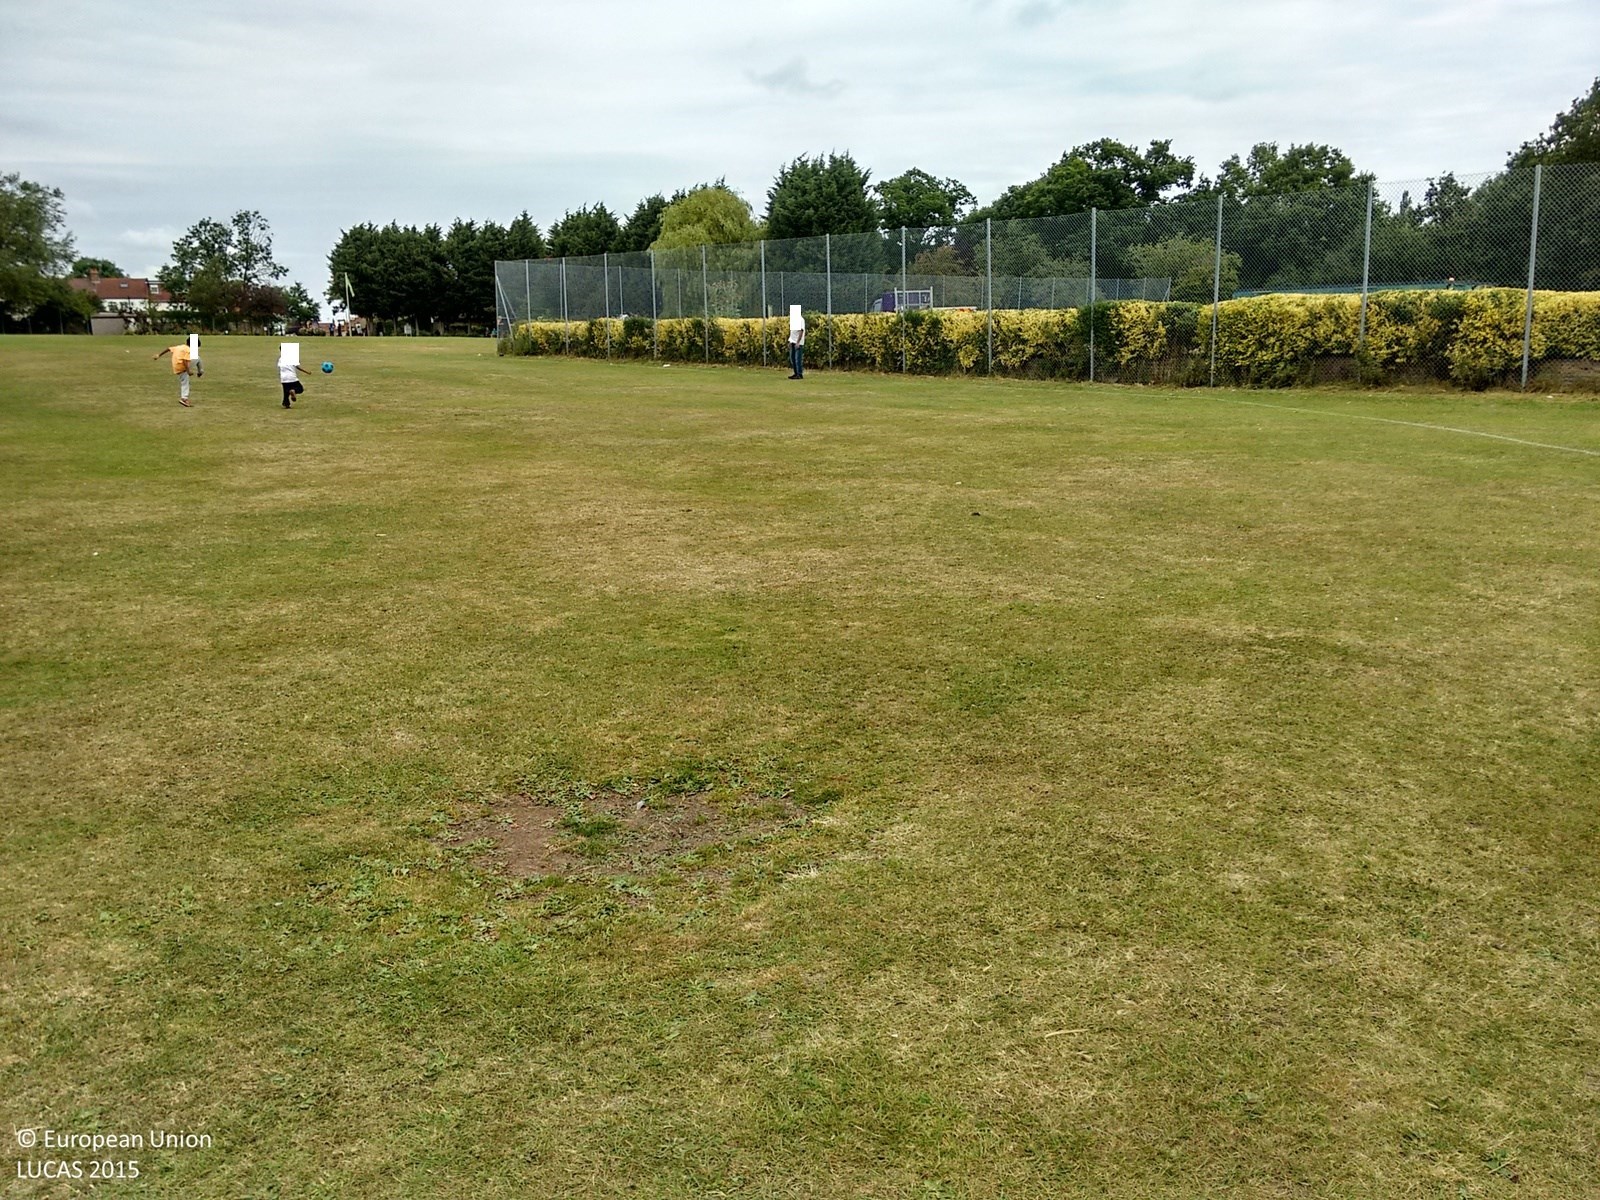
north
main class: Grassland
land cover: Grassland without tree/shrub cover
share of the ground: > 75 %
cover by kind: herbaceous plants 100 %
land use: Amenities, museums, leisure
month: July
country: GB
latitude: 51.5612
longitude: -0.3505
